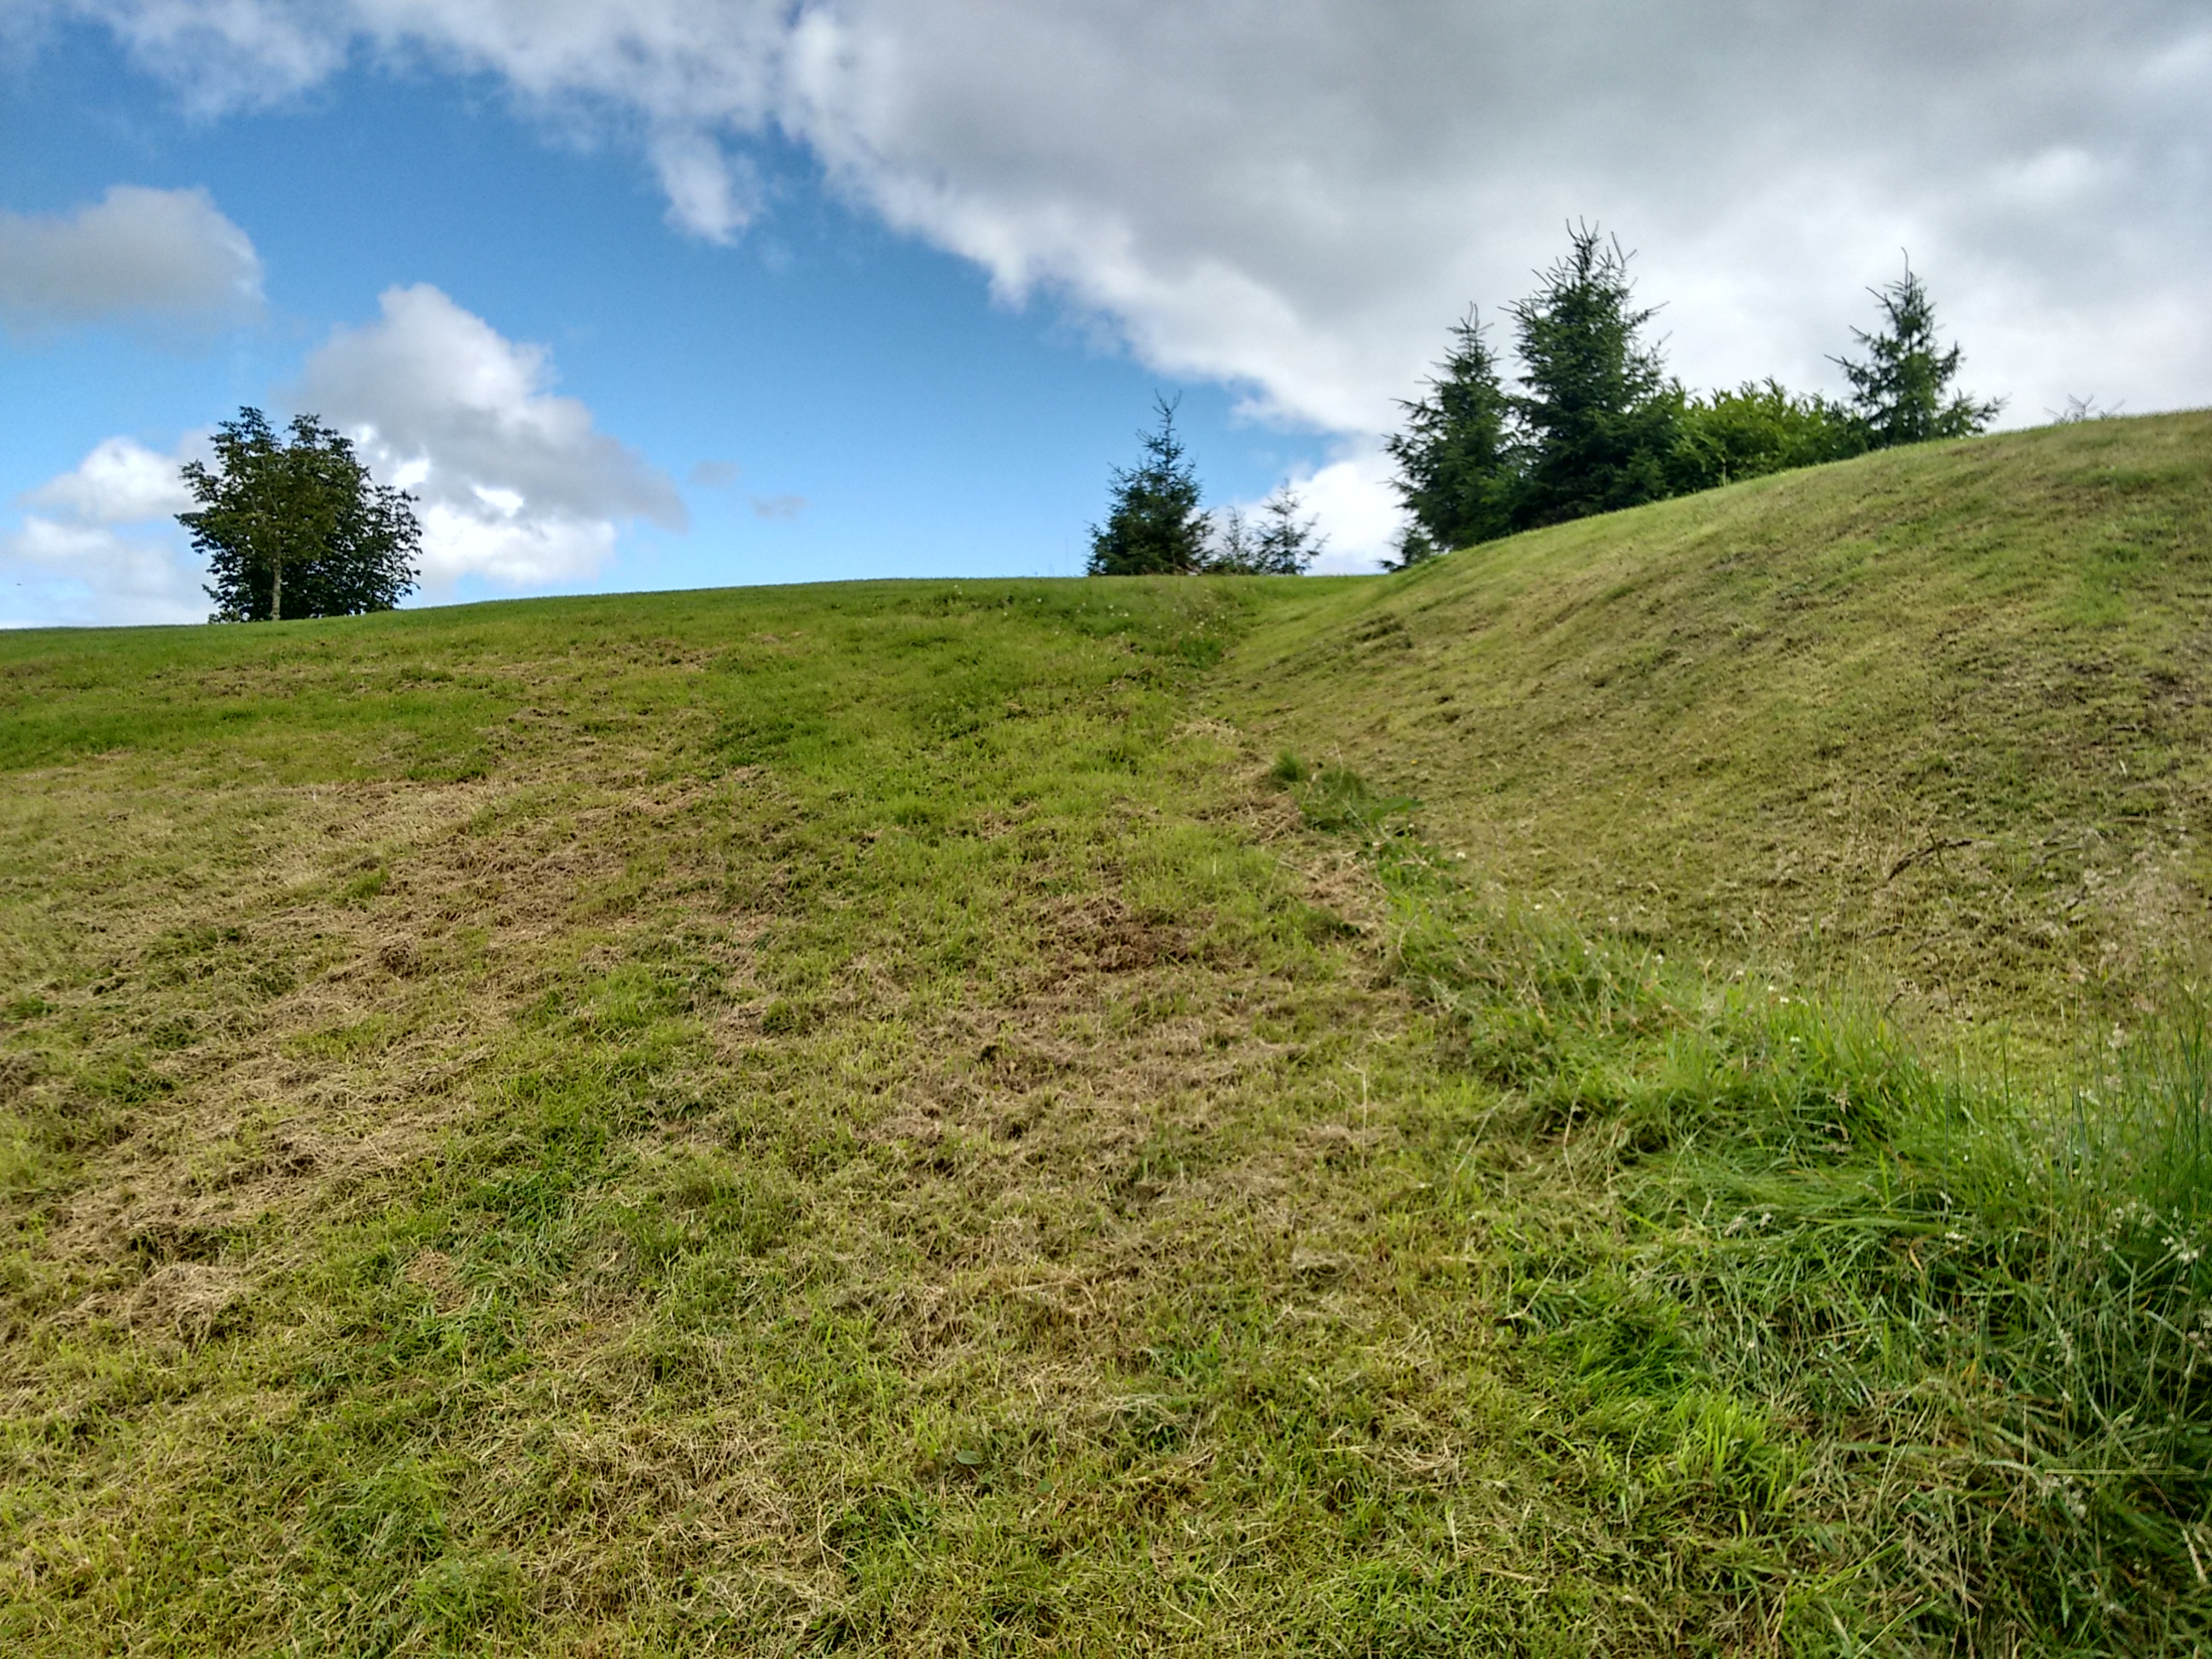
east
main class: Grassland
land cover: Grassland with sparse tree/shrub cover
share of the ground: > 75 %
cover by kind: herbaceous plants 95 %, coniferous forest trees 5 %
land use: Sport
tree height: > 5 m
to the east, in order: Grassland with sparse tree/shrub cover; Sand; Grassland with sparse tree/shrub cover; Abandoned hedges; Fences; Grassland without tree/shrub cover; Paved roads, cycling and walking lanes; Grass margins; Fences; Grassland without tree/shrub cover
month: July
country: GB
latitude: 54.3657
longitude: -7.3426
